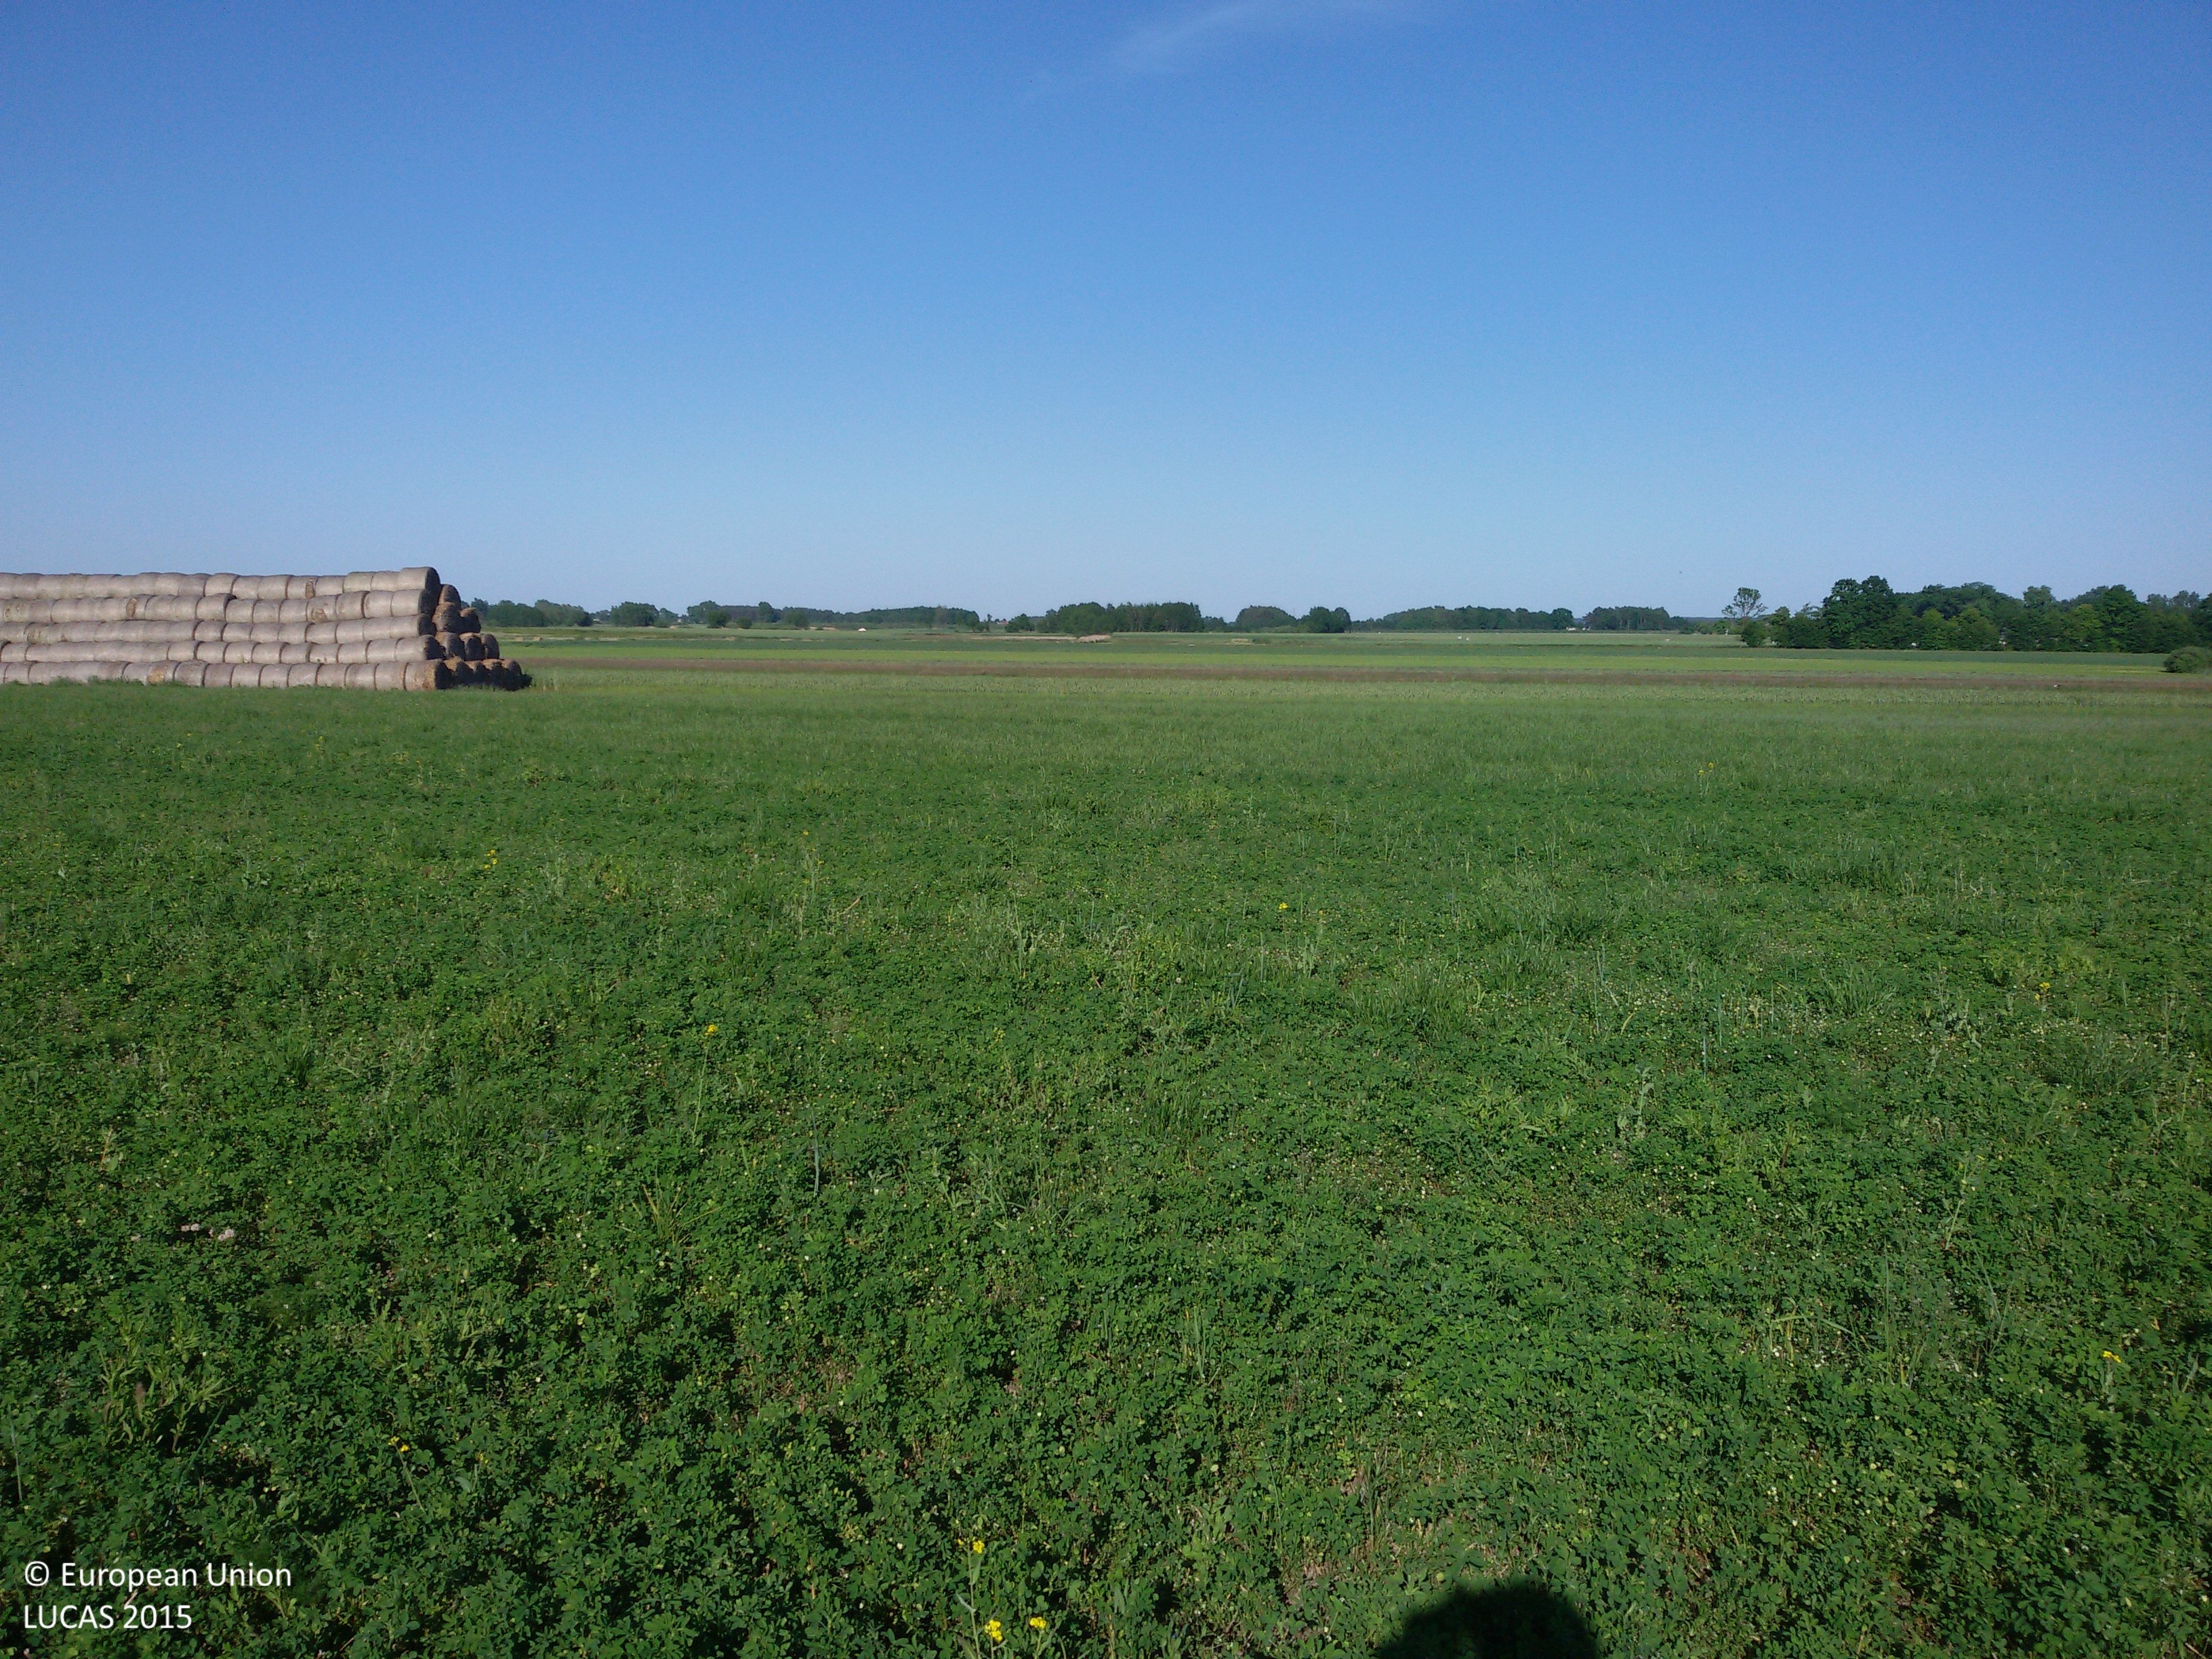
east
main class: Cropland
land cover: Lucerne
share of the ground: > 75 %
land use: Agriculture (excluding fallow land and kitchen gardens)
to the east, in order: Lucerne; Triticale; Oats; Grassland without tree/shrub cover
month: June
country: PL
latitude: 53.1601
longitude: 17.0539
